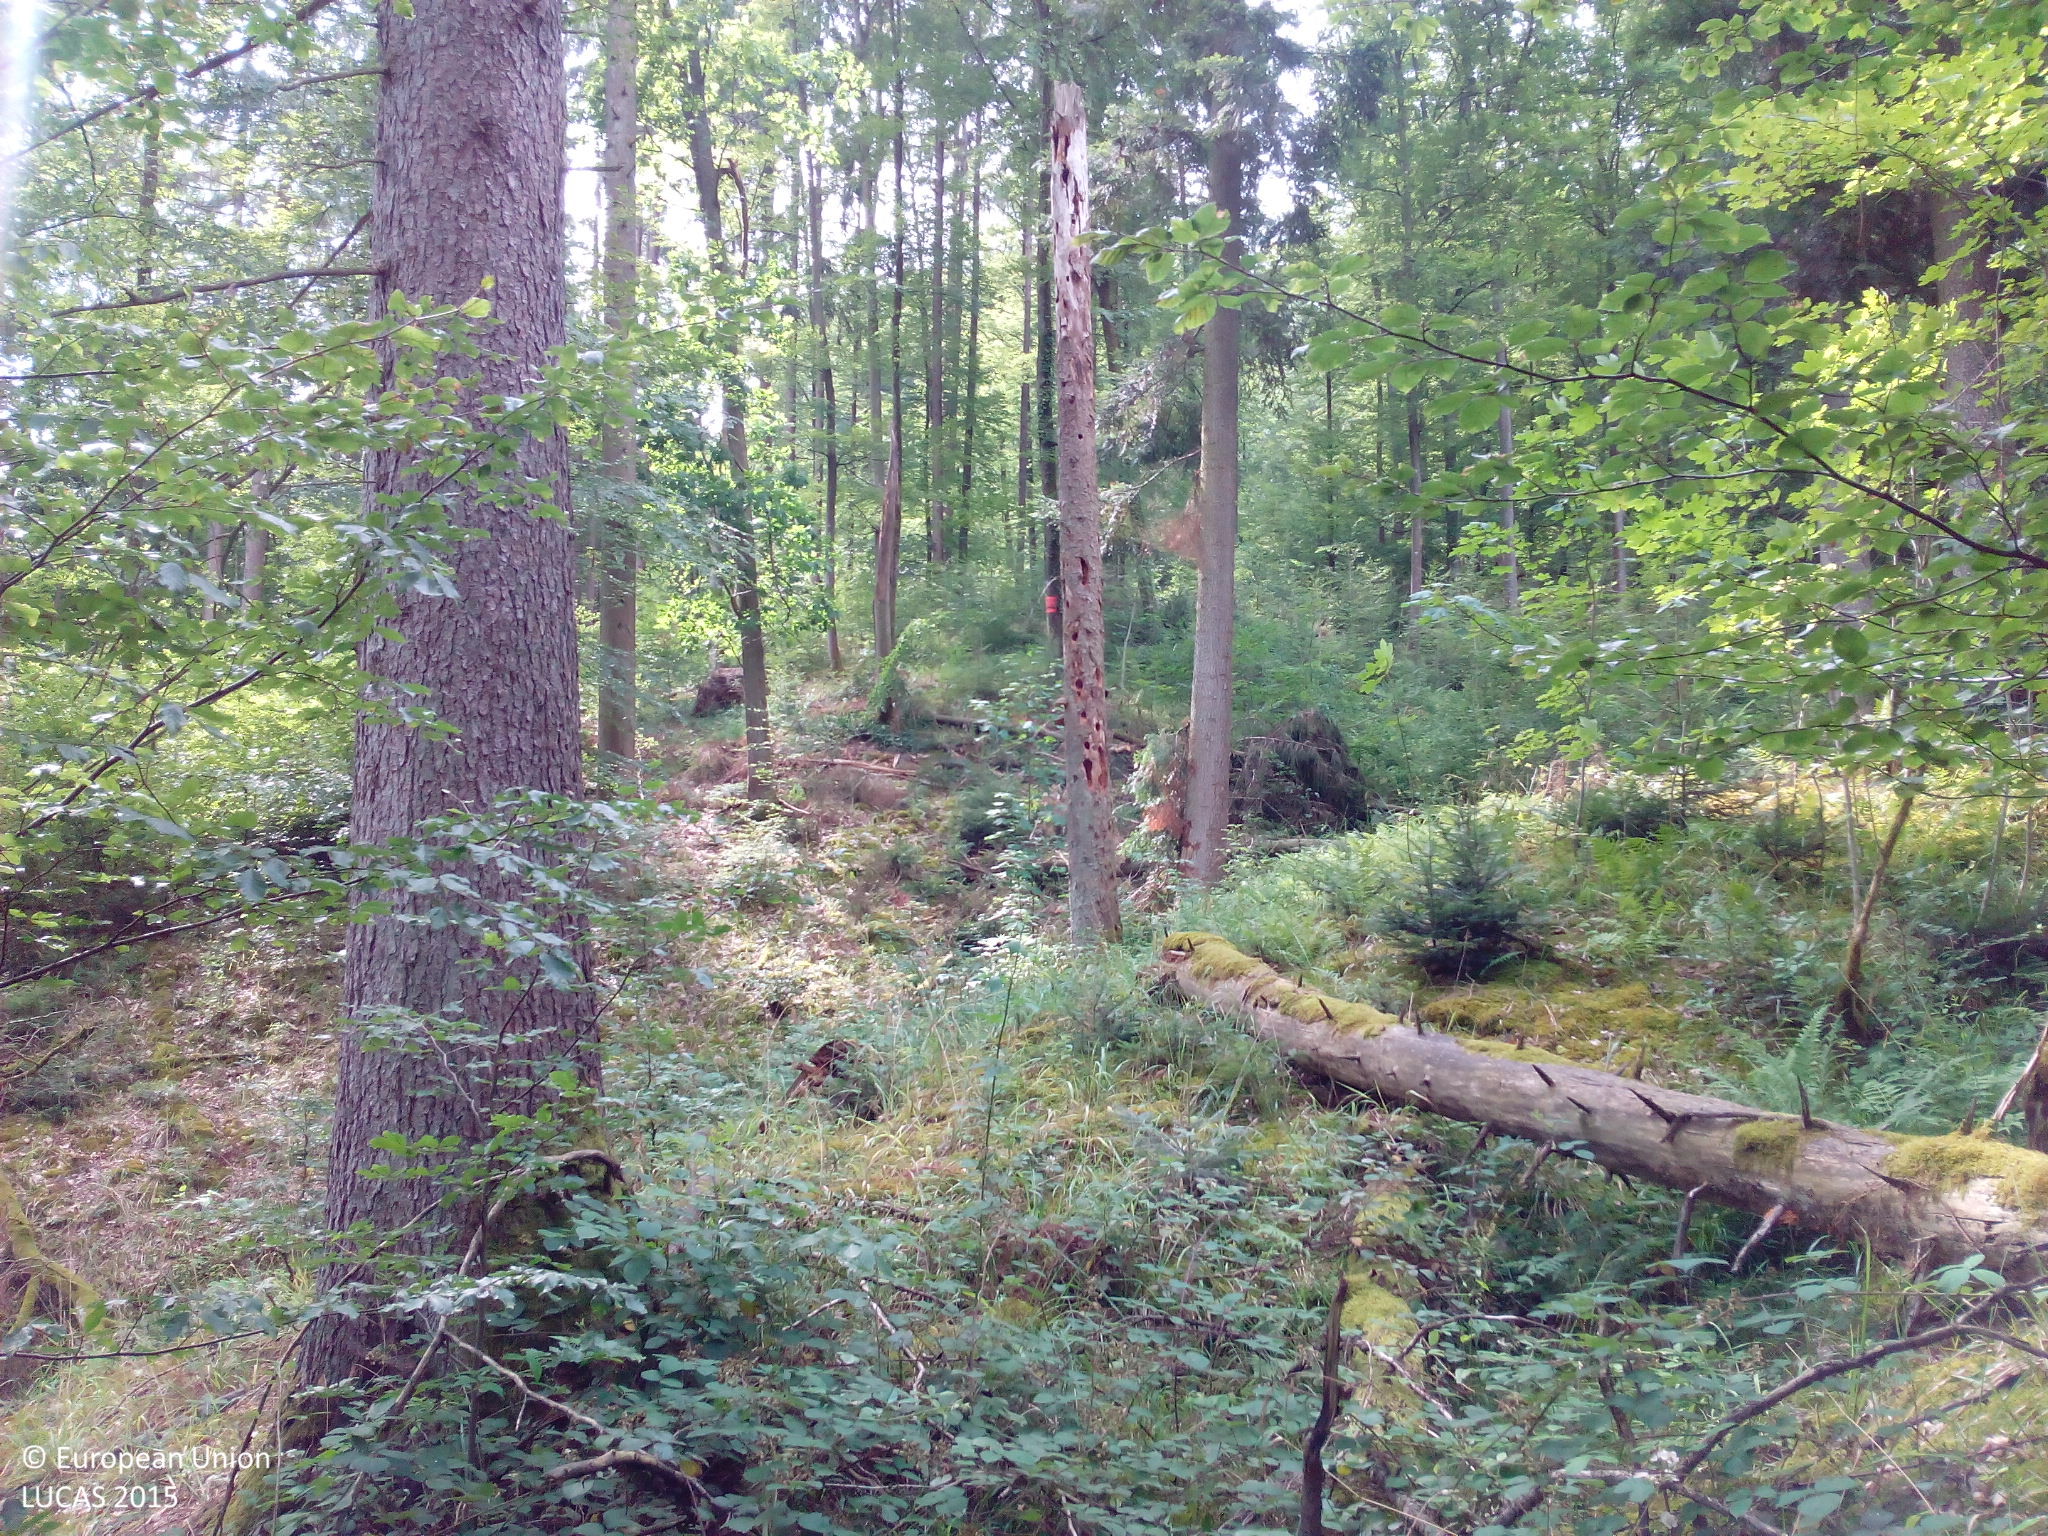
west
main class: Woodland
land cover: Other mixed woodland
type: hemiboreal forest and nemoral coniferous forest and mixed broadleaved-coniferous forest
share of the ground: > 75 %
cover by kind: coniferous forest trees 55 %, broadleaved forest trees 25 %, lichens and mosses 15 %, shrubs 5 %
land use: Forestry
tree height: > 5 m
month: July
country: DE
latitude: 49.0507
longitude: 9.6854
